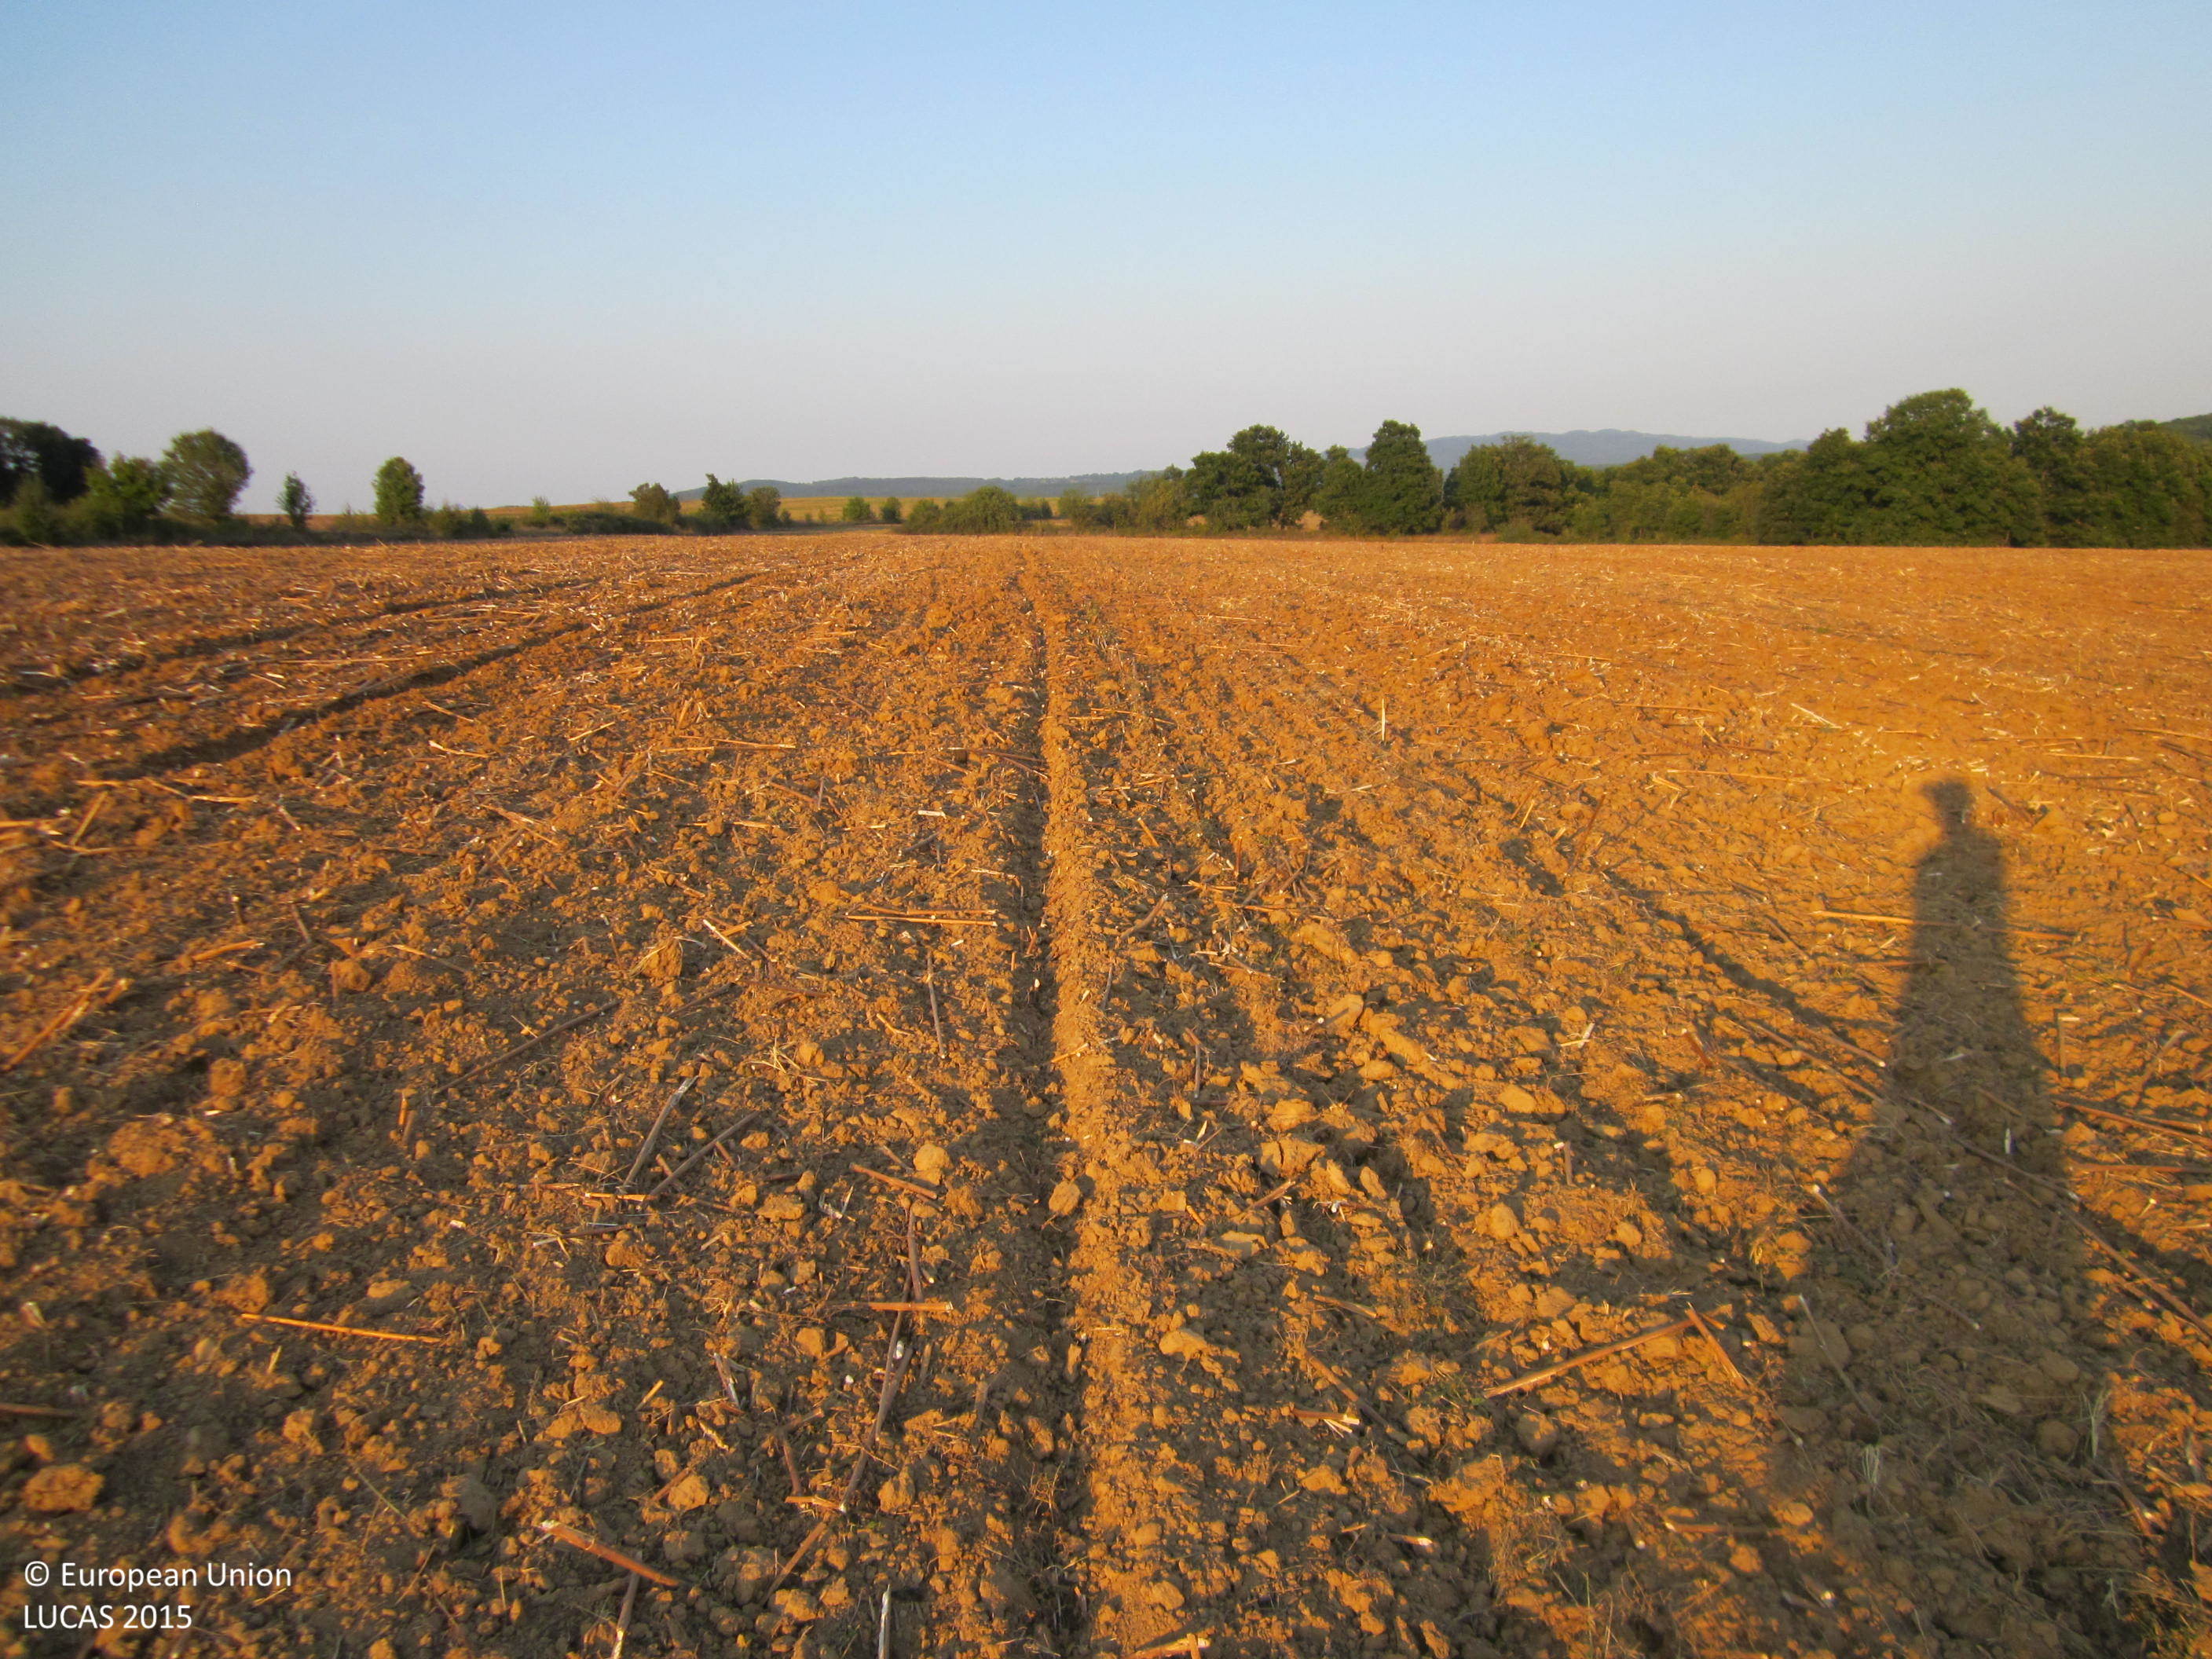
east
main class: Cropland
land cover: Sunflower
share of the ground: < 10 %
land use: Agriculture (excluding fallow land and kitchen gardens)
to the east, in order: Sunflower; Grass margins; Tracks; Grass margins; Shruby margins; Broadleaved woodland; Grassland with sparse tree/shrub cover
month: September
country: BG
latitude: 42.8258
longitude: 27.1022
